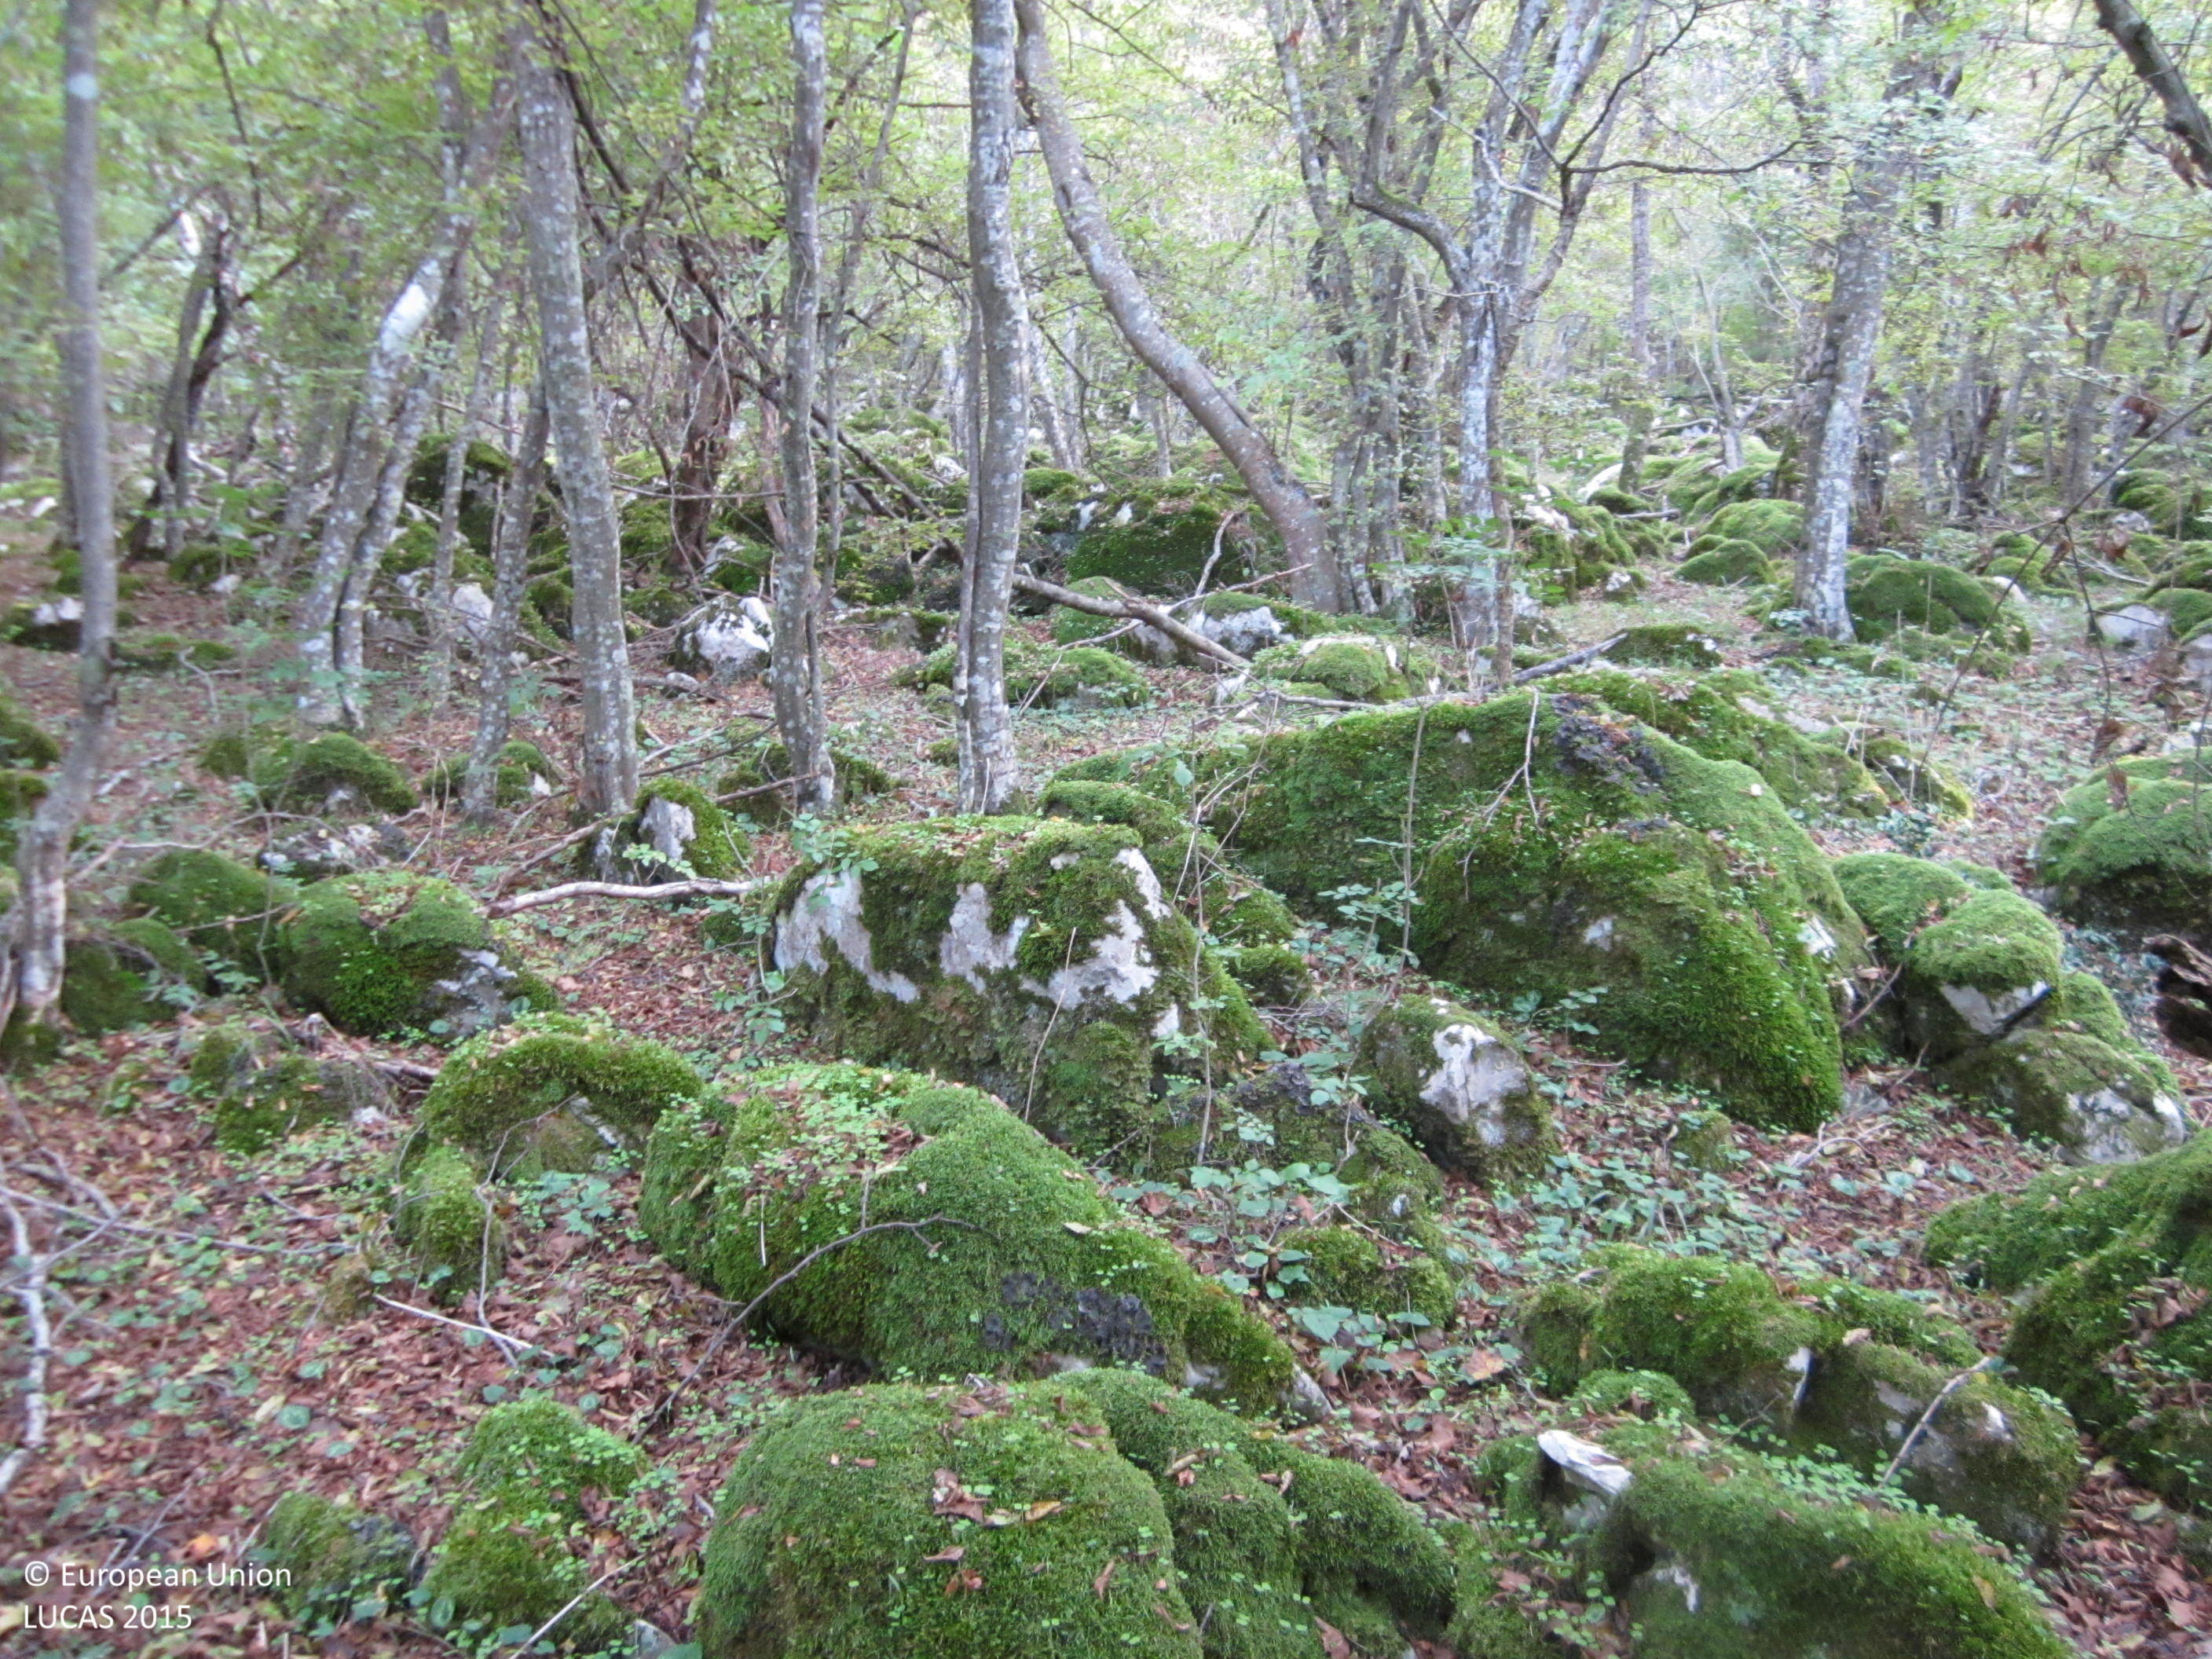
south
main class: Woodland
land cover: Broadleaved woodland
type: mesophytic deciduous forest
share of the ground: > 75 %
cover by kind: broadleaved forest trees 90 %, lichens and mosses 5 %, unconsolidated bare surface 5 %
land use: Forestry
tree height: > 5 m
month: October
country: BG
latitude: 42.2116
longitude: 27.2469
